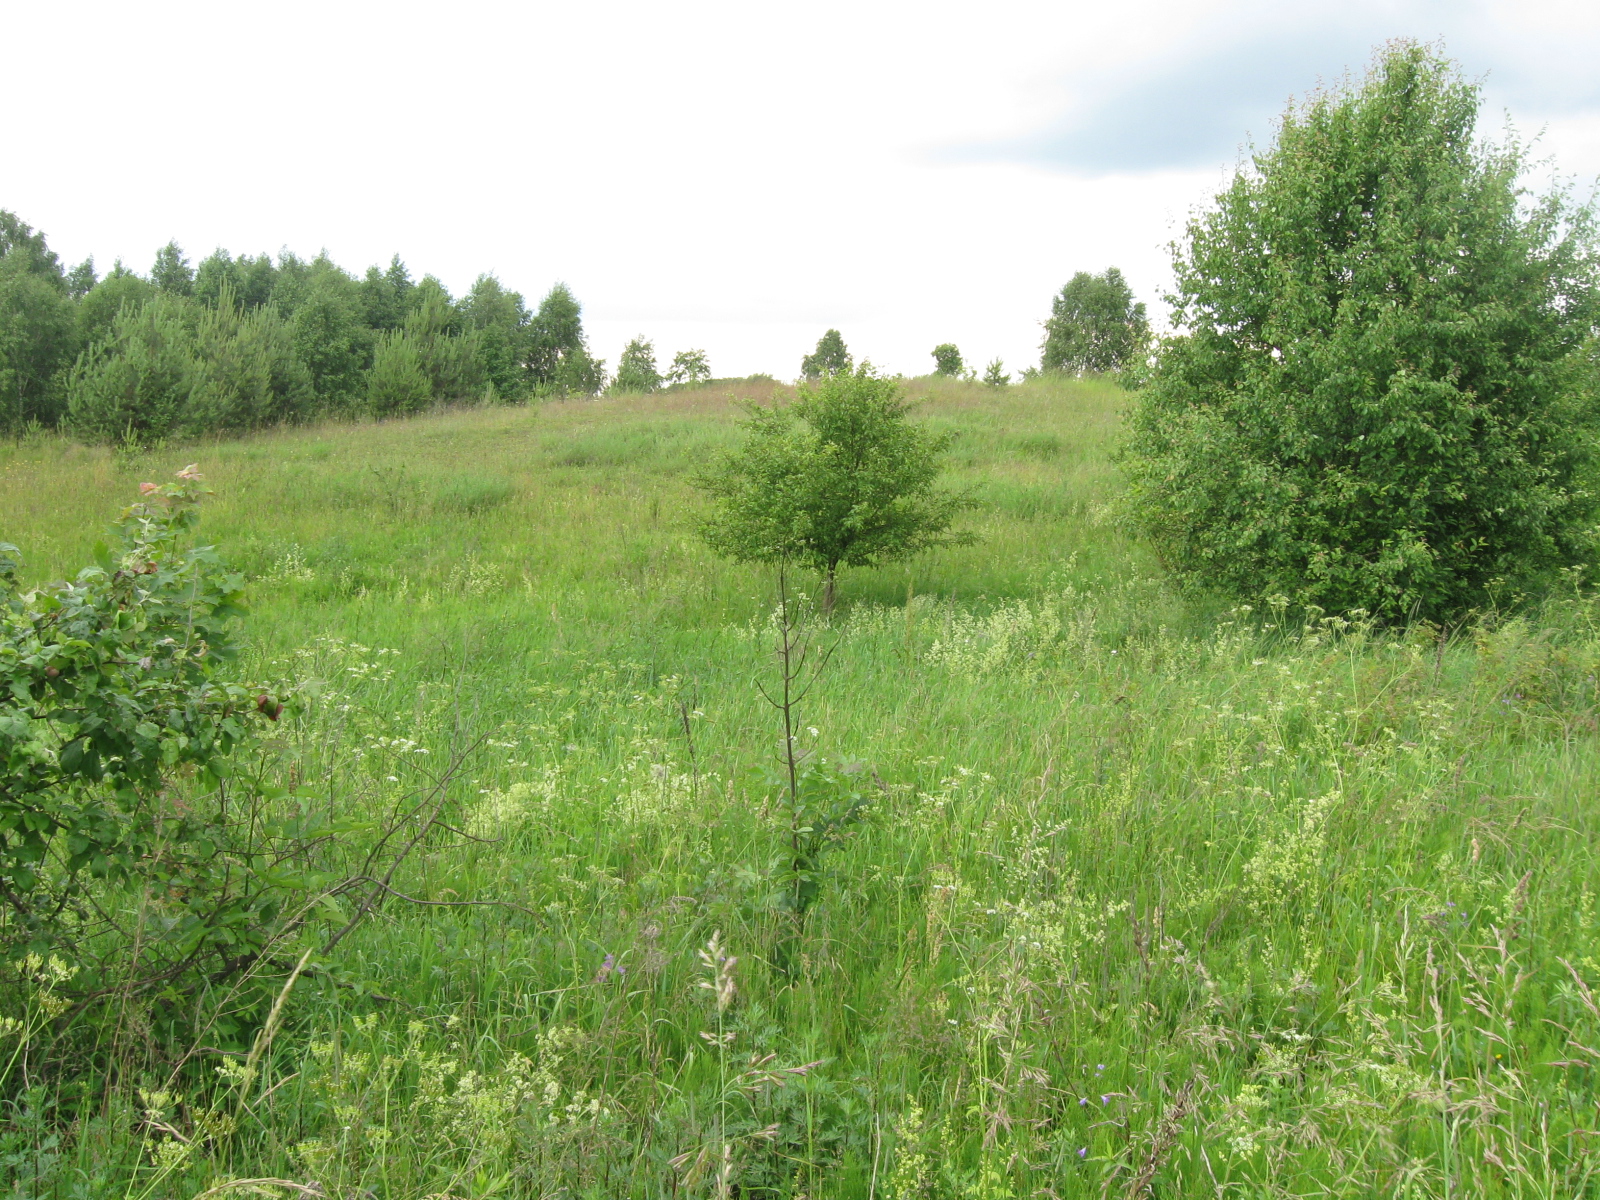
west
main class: Grassland
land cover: Grassland with sparse tree/shrub cover
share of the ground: > 75 %
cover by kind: herbaceous plants 90 %, broadleaved forest trees 5 %, shrubs 5 %
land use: Agriculture (excluding fallow land and kitchen gardens)
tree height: < 5 m
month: June
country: LT
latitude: 54.5638
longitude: 24.4064
